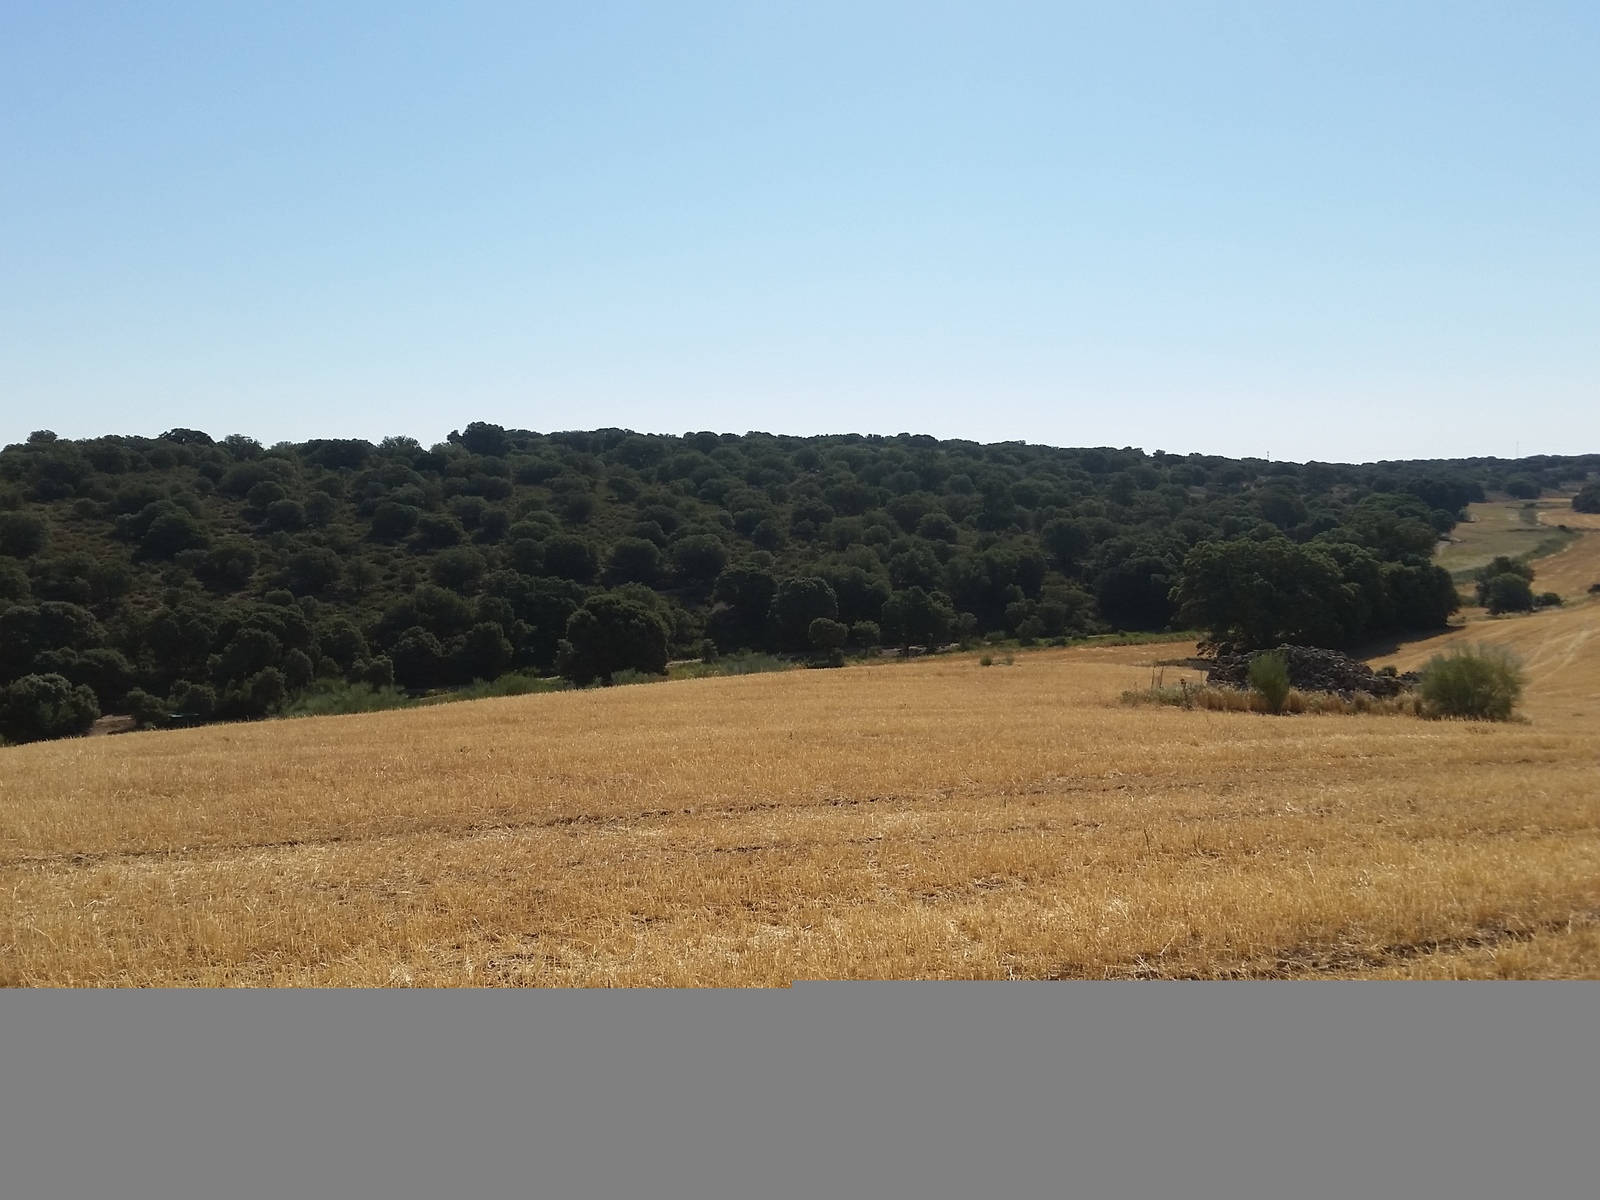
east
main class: Cropland
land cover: Barley
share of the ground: < 10 %
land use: Agriculture (excluding fallow land and kitchen gardens)
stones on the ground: 10 - 25 %
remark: Harvested field
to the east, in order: Barley; Grass margins; Barley; Grass margins; Ditches and canals; Grass margins; Broadleaved woodland; Tracks; Broadleaved woodland
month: July
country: ES
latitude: 39.0027
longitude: -2.5346
